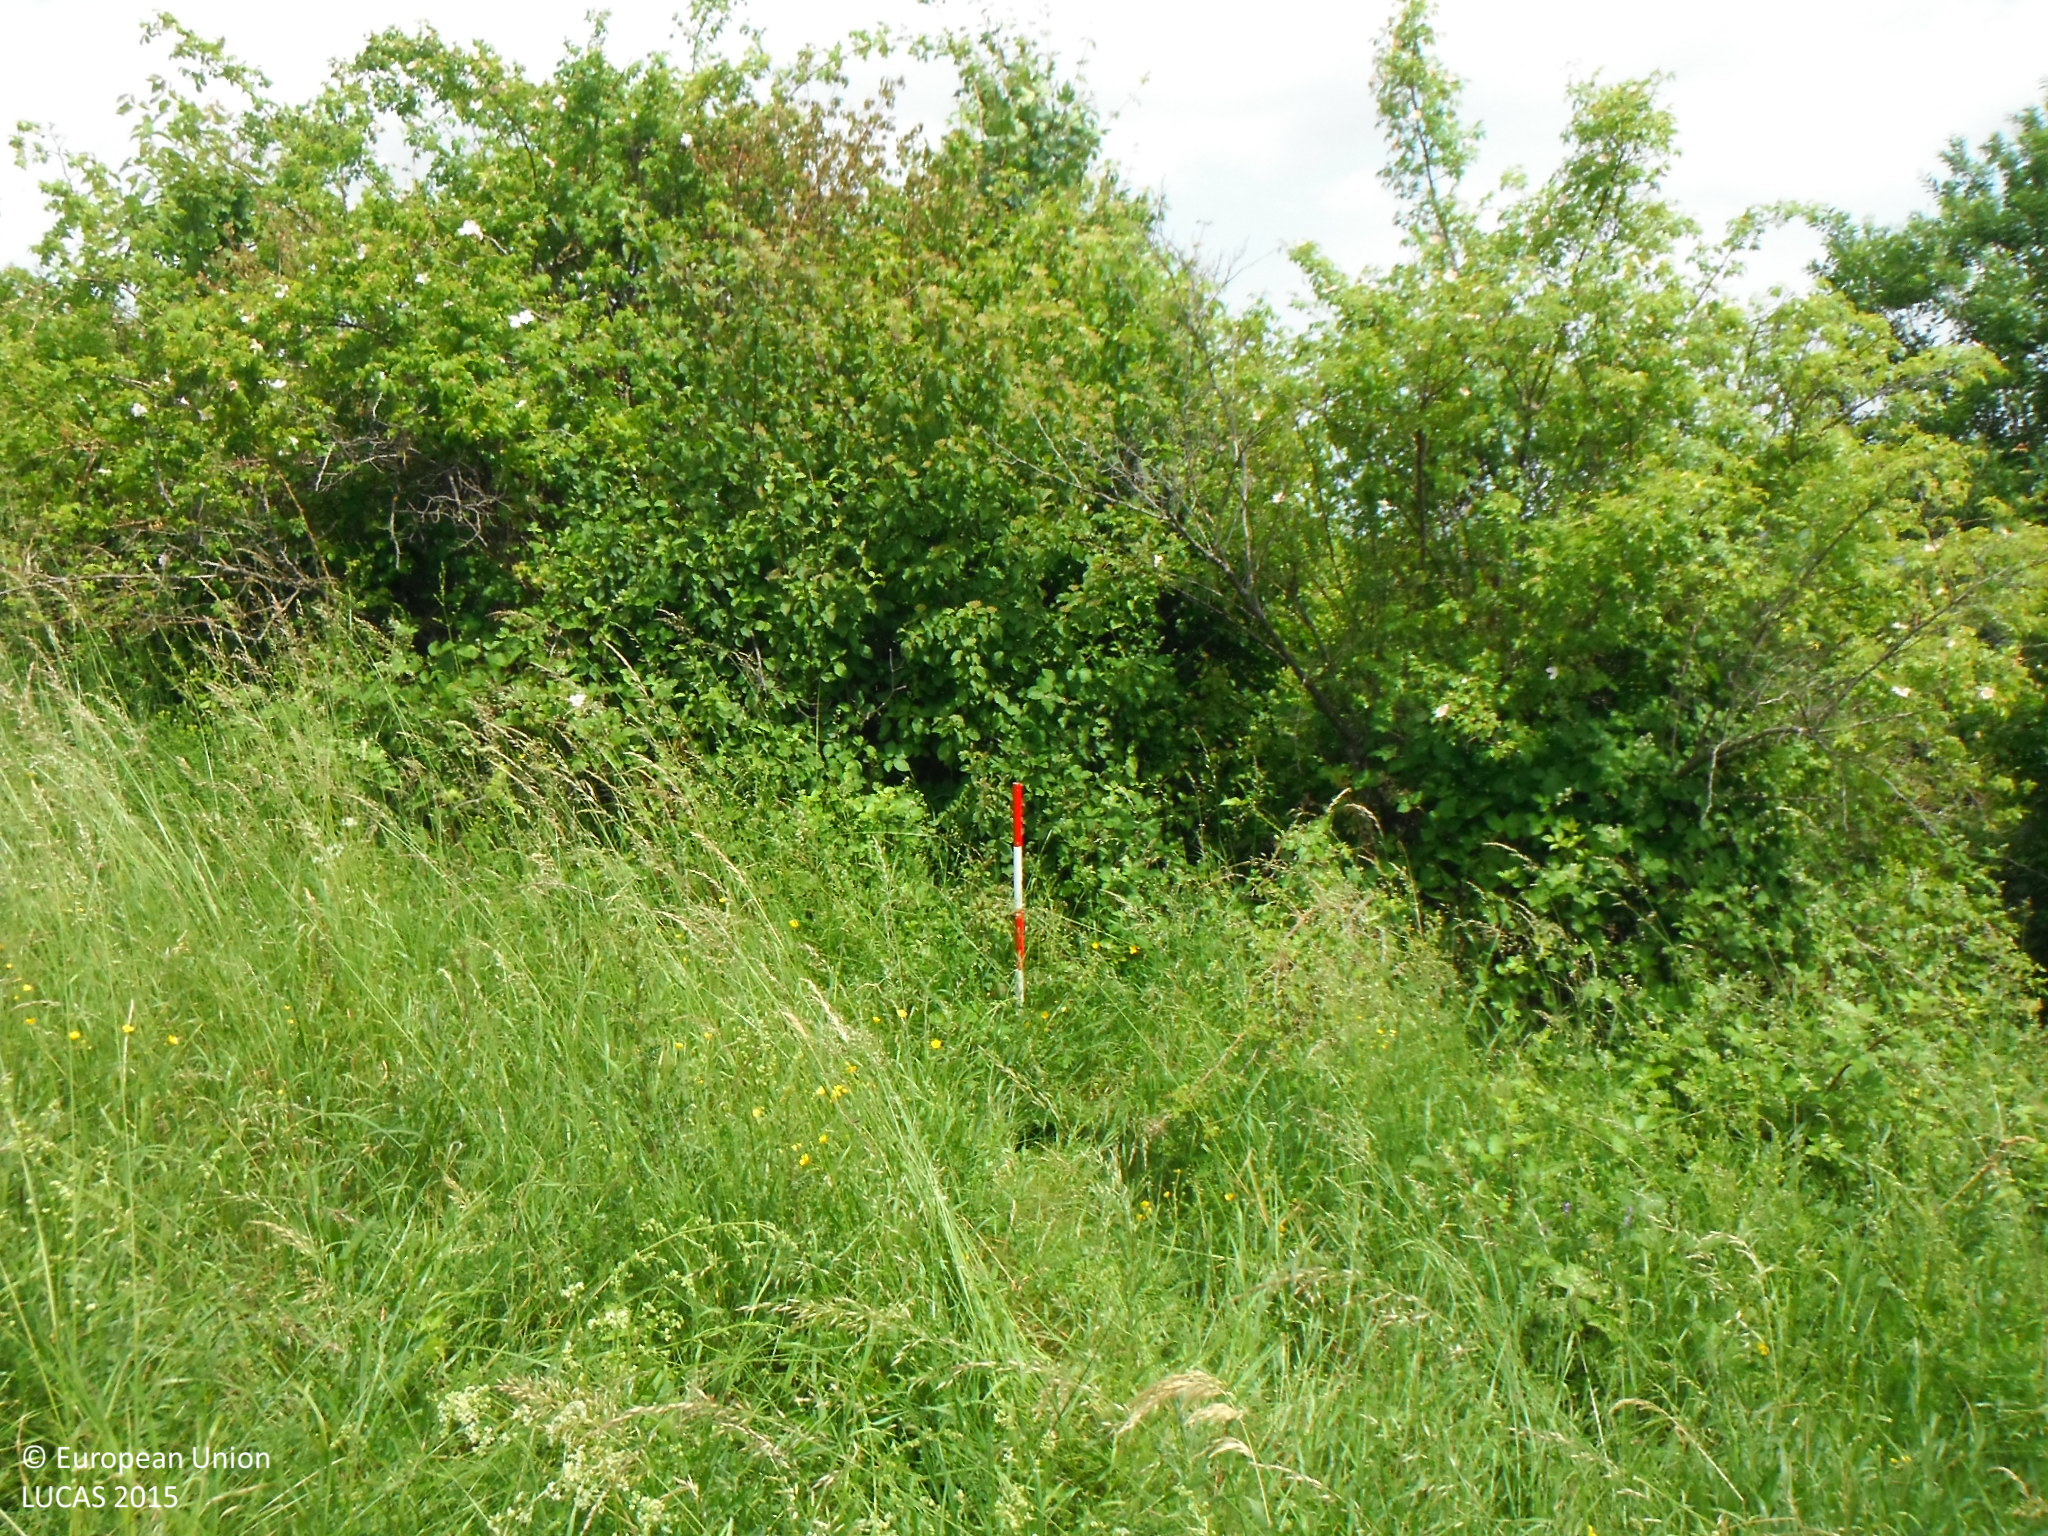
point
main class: Shrubland
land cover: Shrubland without tree cover
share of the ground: 50 - 75 %
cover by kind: shrubs 60 %, herbaceous plants 40 %
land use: Abandoned areas
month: June
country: SK
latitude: 49.1918
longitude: 21.2285
